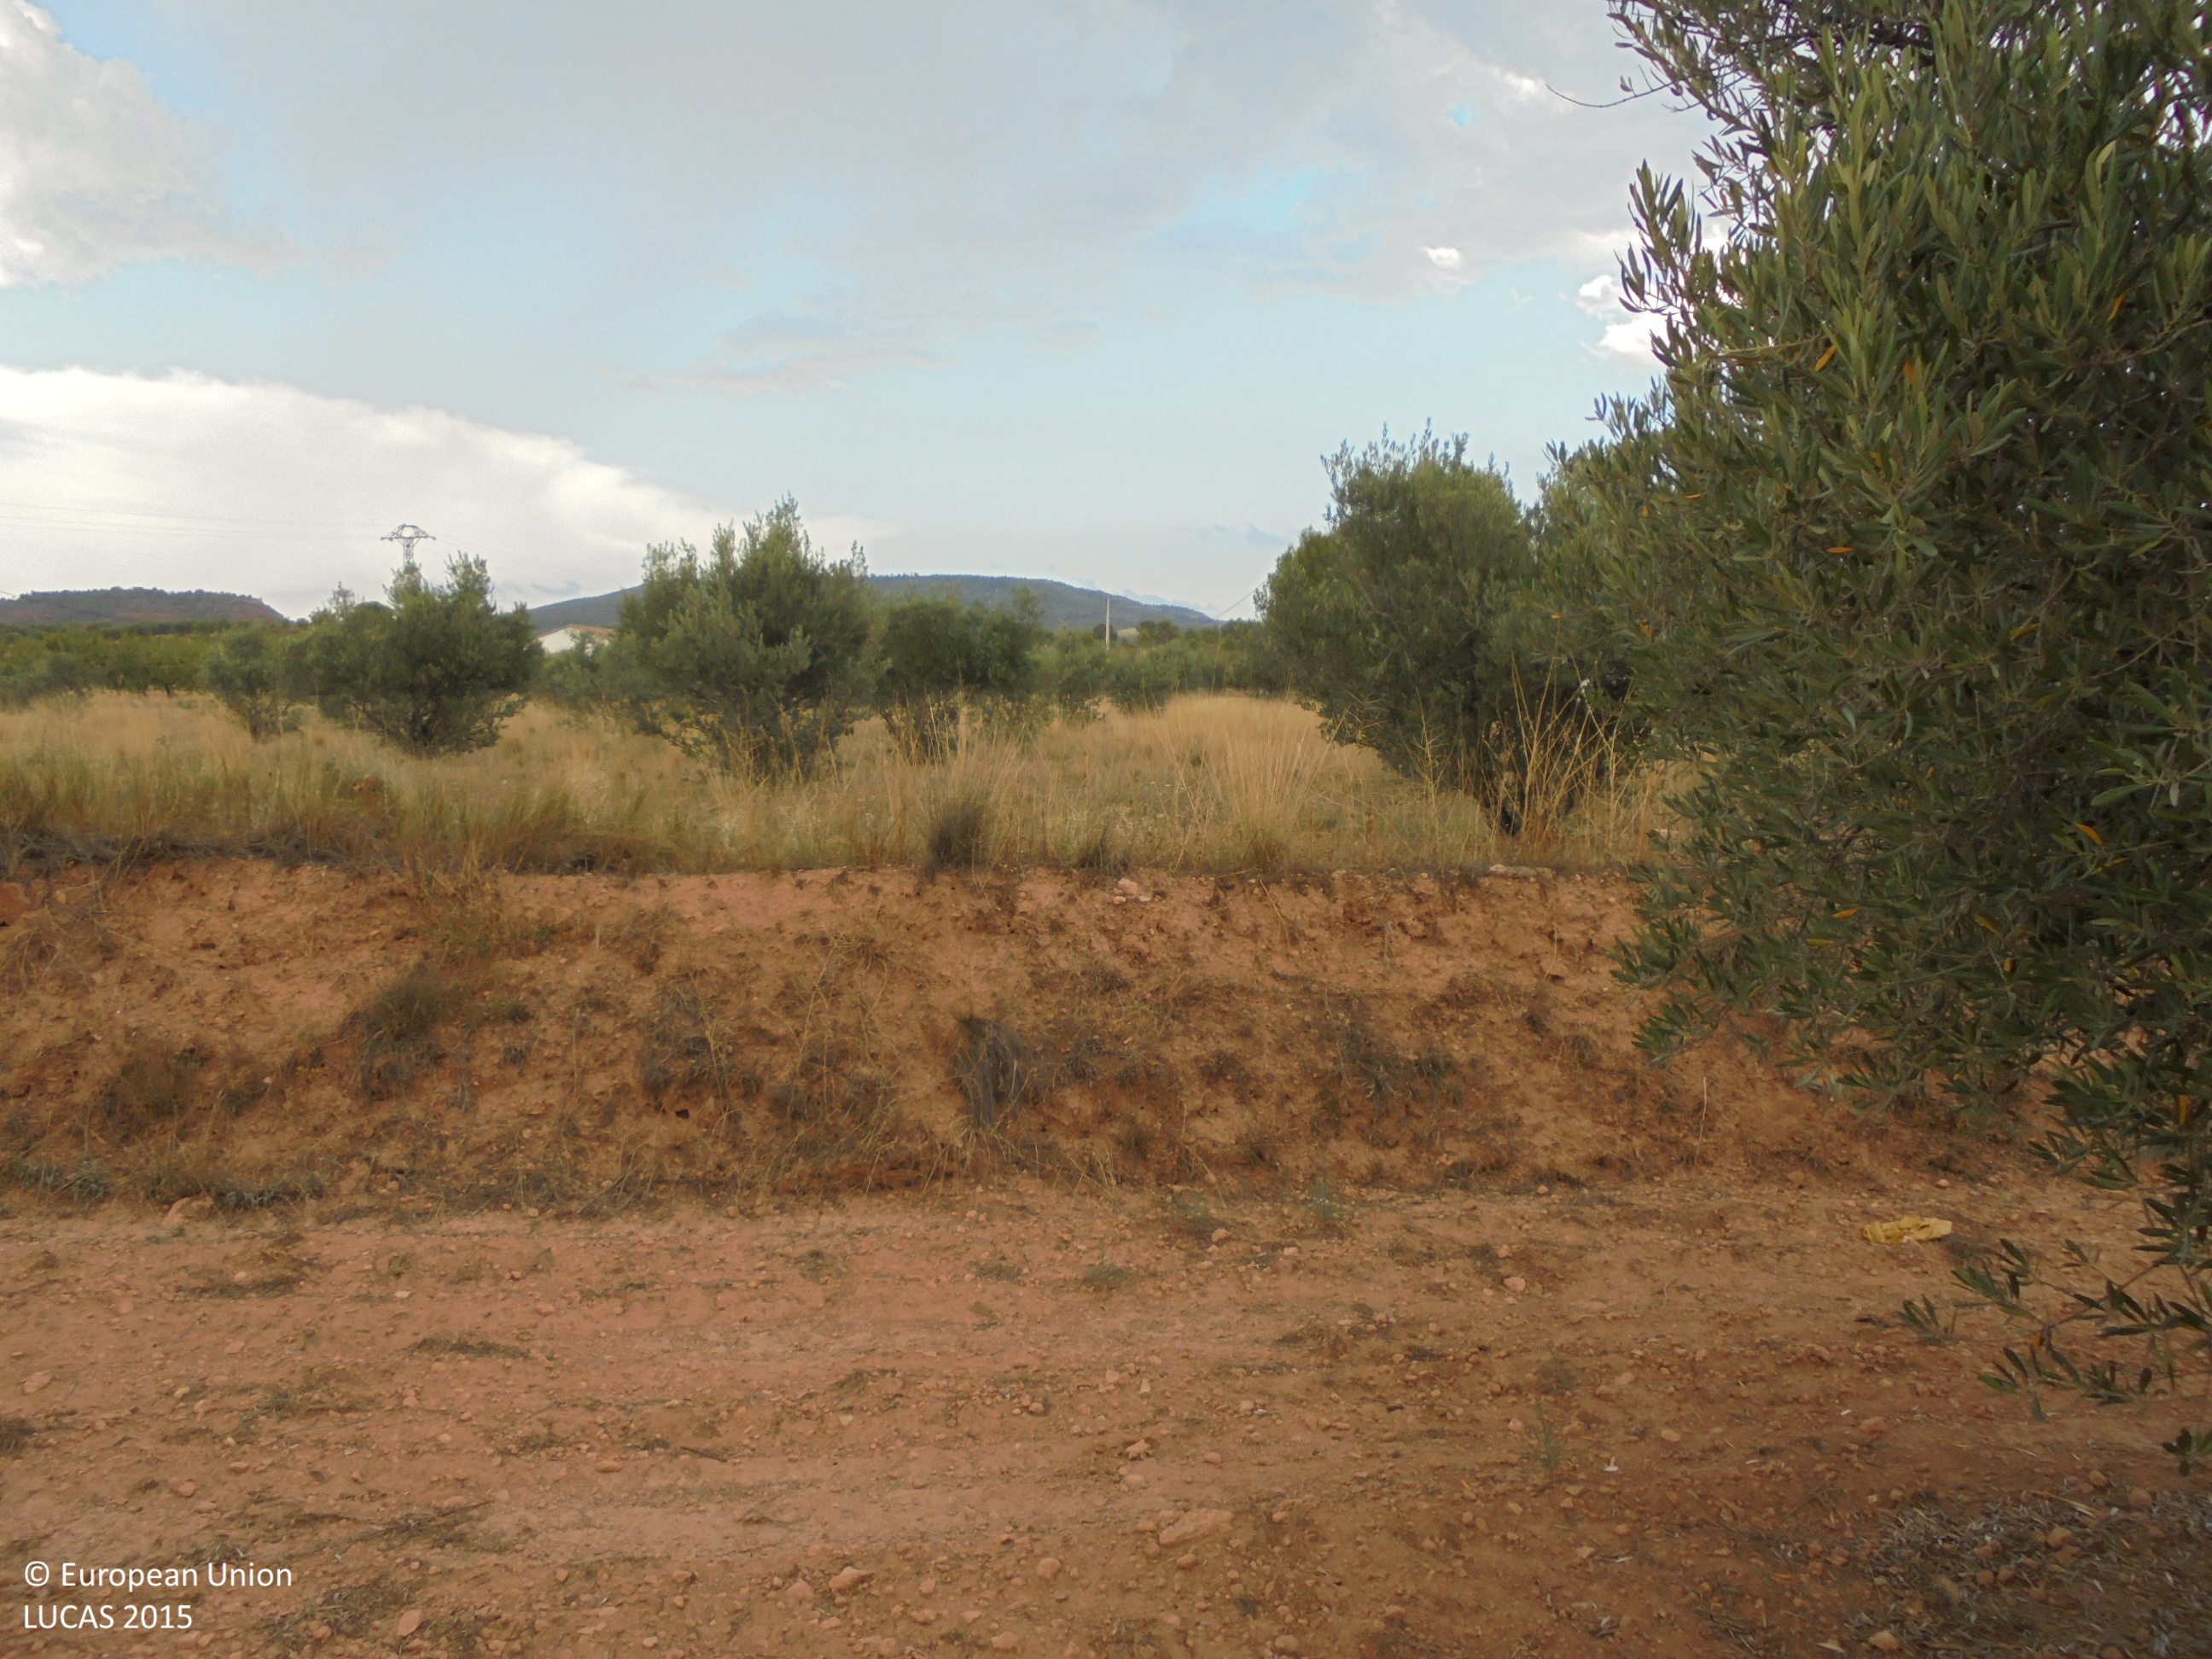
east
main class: Cropland
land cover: Olive groves
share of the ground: 25 - 50 %
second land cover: Other bare soil
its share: > 75 %
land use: Agriculture (excluding fallow land and kitchen gardens)
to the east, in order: Olive groves; Other bare soil; Grass margins; Olive groves; Tracks; Fences; Pine dominated coniferous woodland; Artificial constructions in urban areas; Pine dominated coniferous woodland; Fences; Tracks; Grass margins; Olive groves; Shruby margins; Olive groves; Tracks; Grass margins; Dry stone walls; Nuts trees
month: July
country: ES
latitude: 39.0591
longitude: -1.0323
